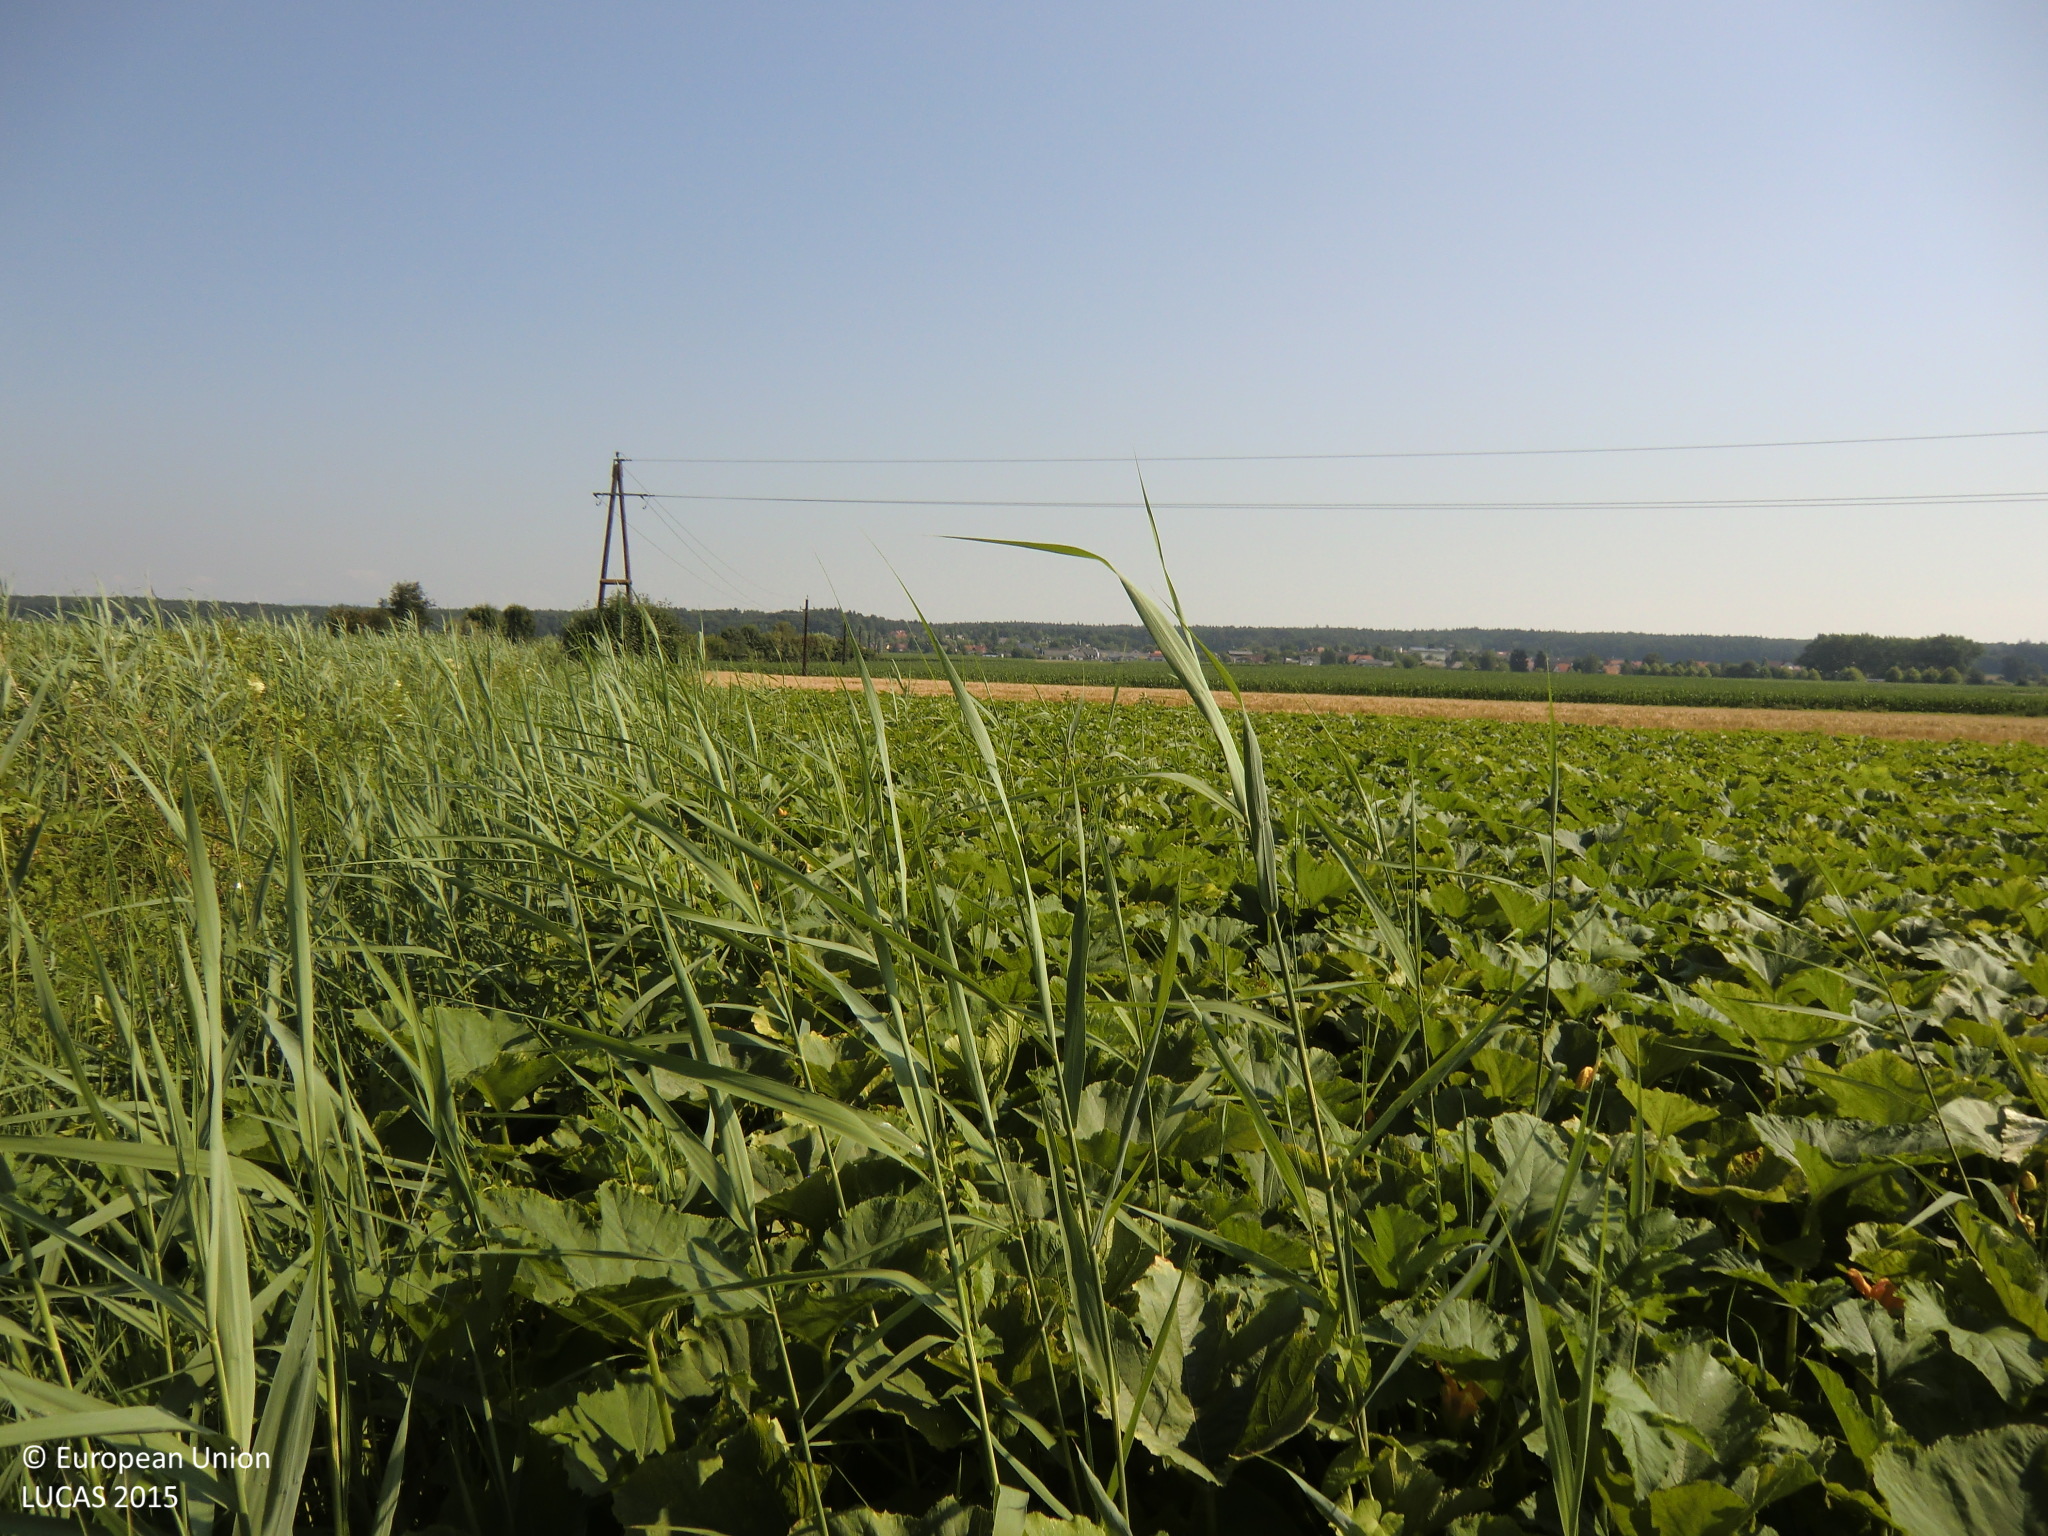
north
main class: Cropland
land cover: Other fibre and oleaginous crops
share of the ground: > 75 %
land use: Agriculture (excluding fallow land and kitchen gardens)
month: July
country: AT
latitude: 47.1261
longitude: 15.9199
